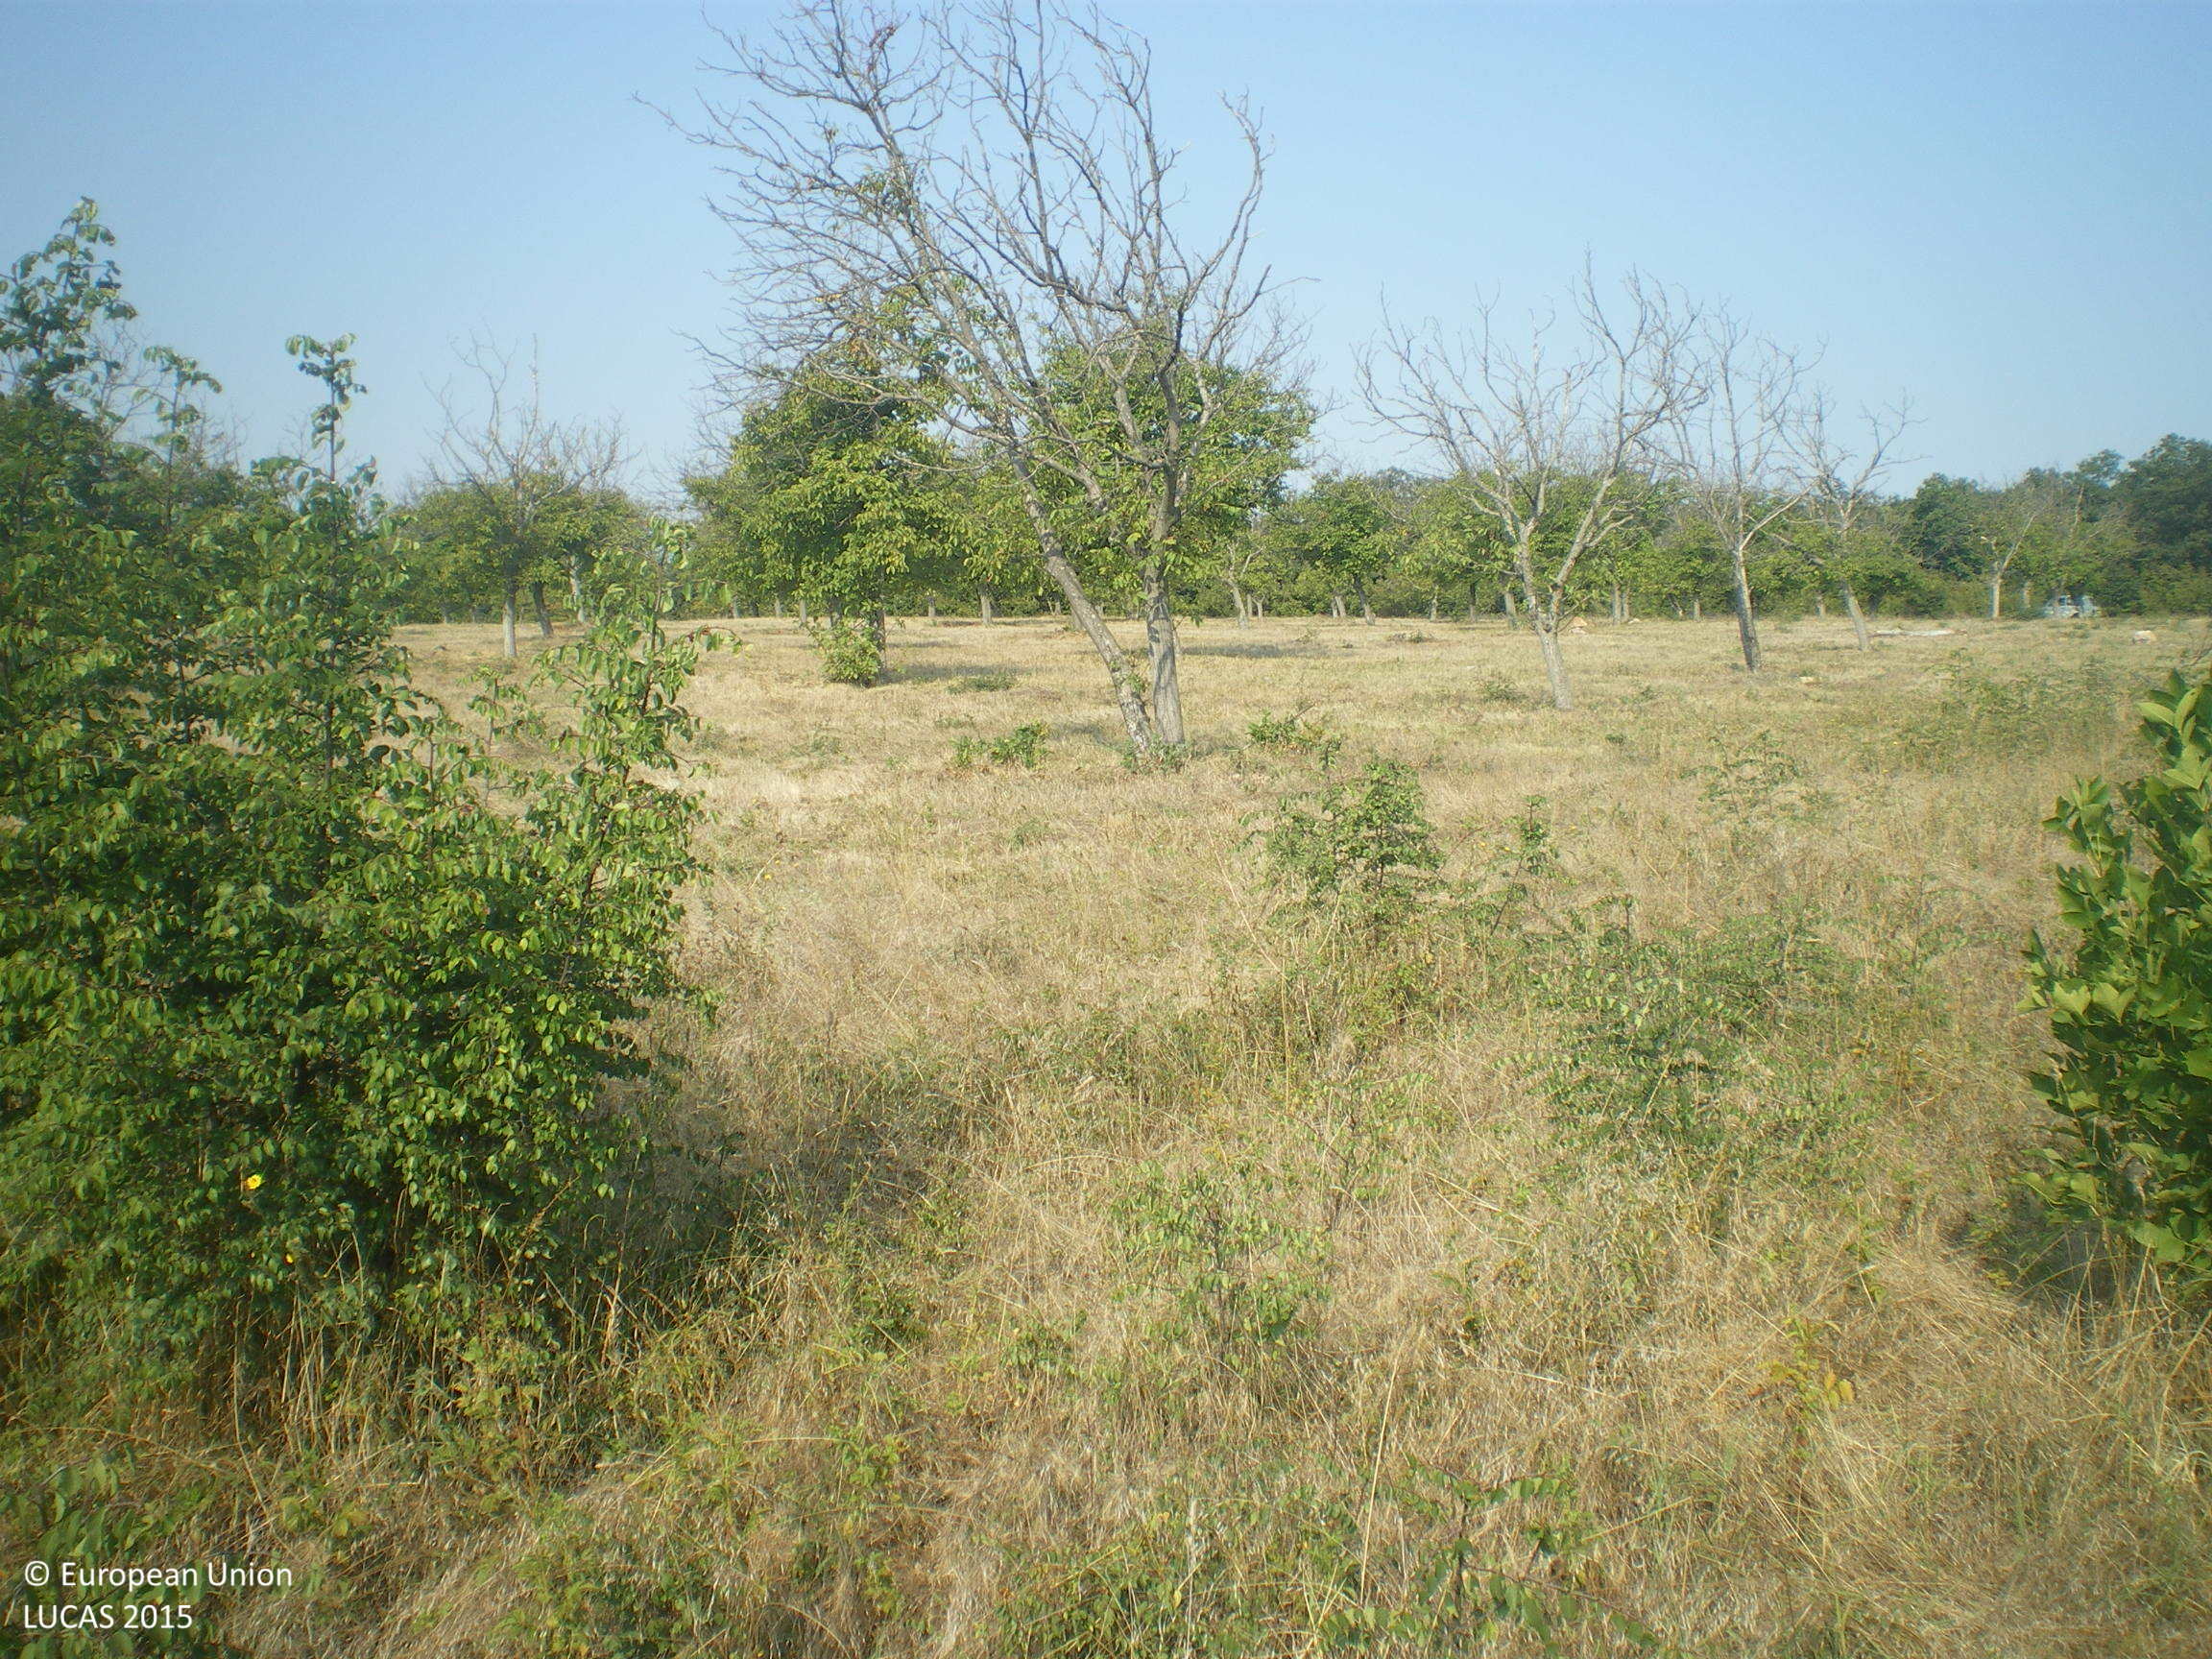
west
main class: Grassland
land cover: Grassland with sparse tree/shrub cover
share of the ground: > 75 %
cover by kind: herbaceous plants 85 %, shrubs 10 %, broadleaved forest trees 5 %
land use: Agriculture (excluding fallow land and kitchen gardens)
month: August
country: BG
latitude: 41.9851
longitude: 25.8464
